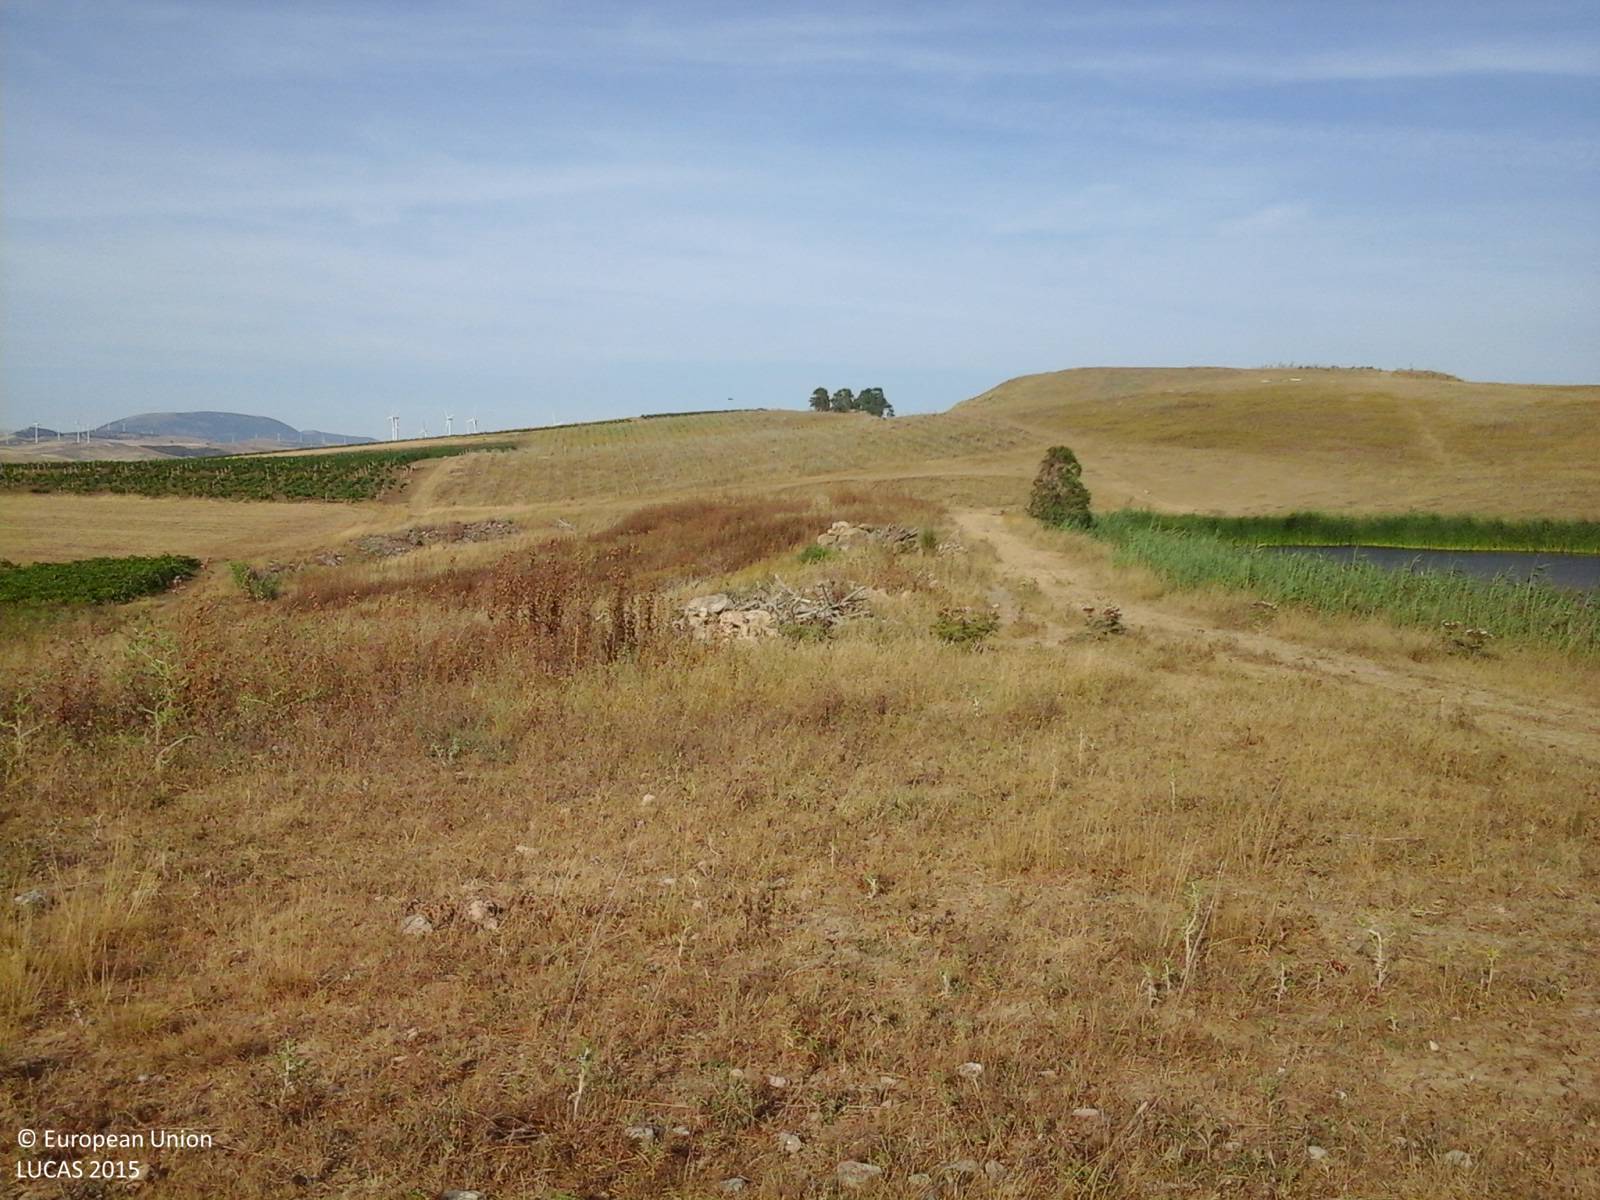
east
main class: Grassland
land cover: Grassland without tree/shrub cover
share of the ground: > 75 %
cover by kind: herbaceous plants 100 %
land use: Agriculture (excluding fallow land and kitchen gardens)
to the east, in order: Grassland without tree/shrub cover; Spontaneously vegetated surfaces
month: June
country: IT
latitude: 37.8033
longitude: 12.5816
